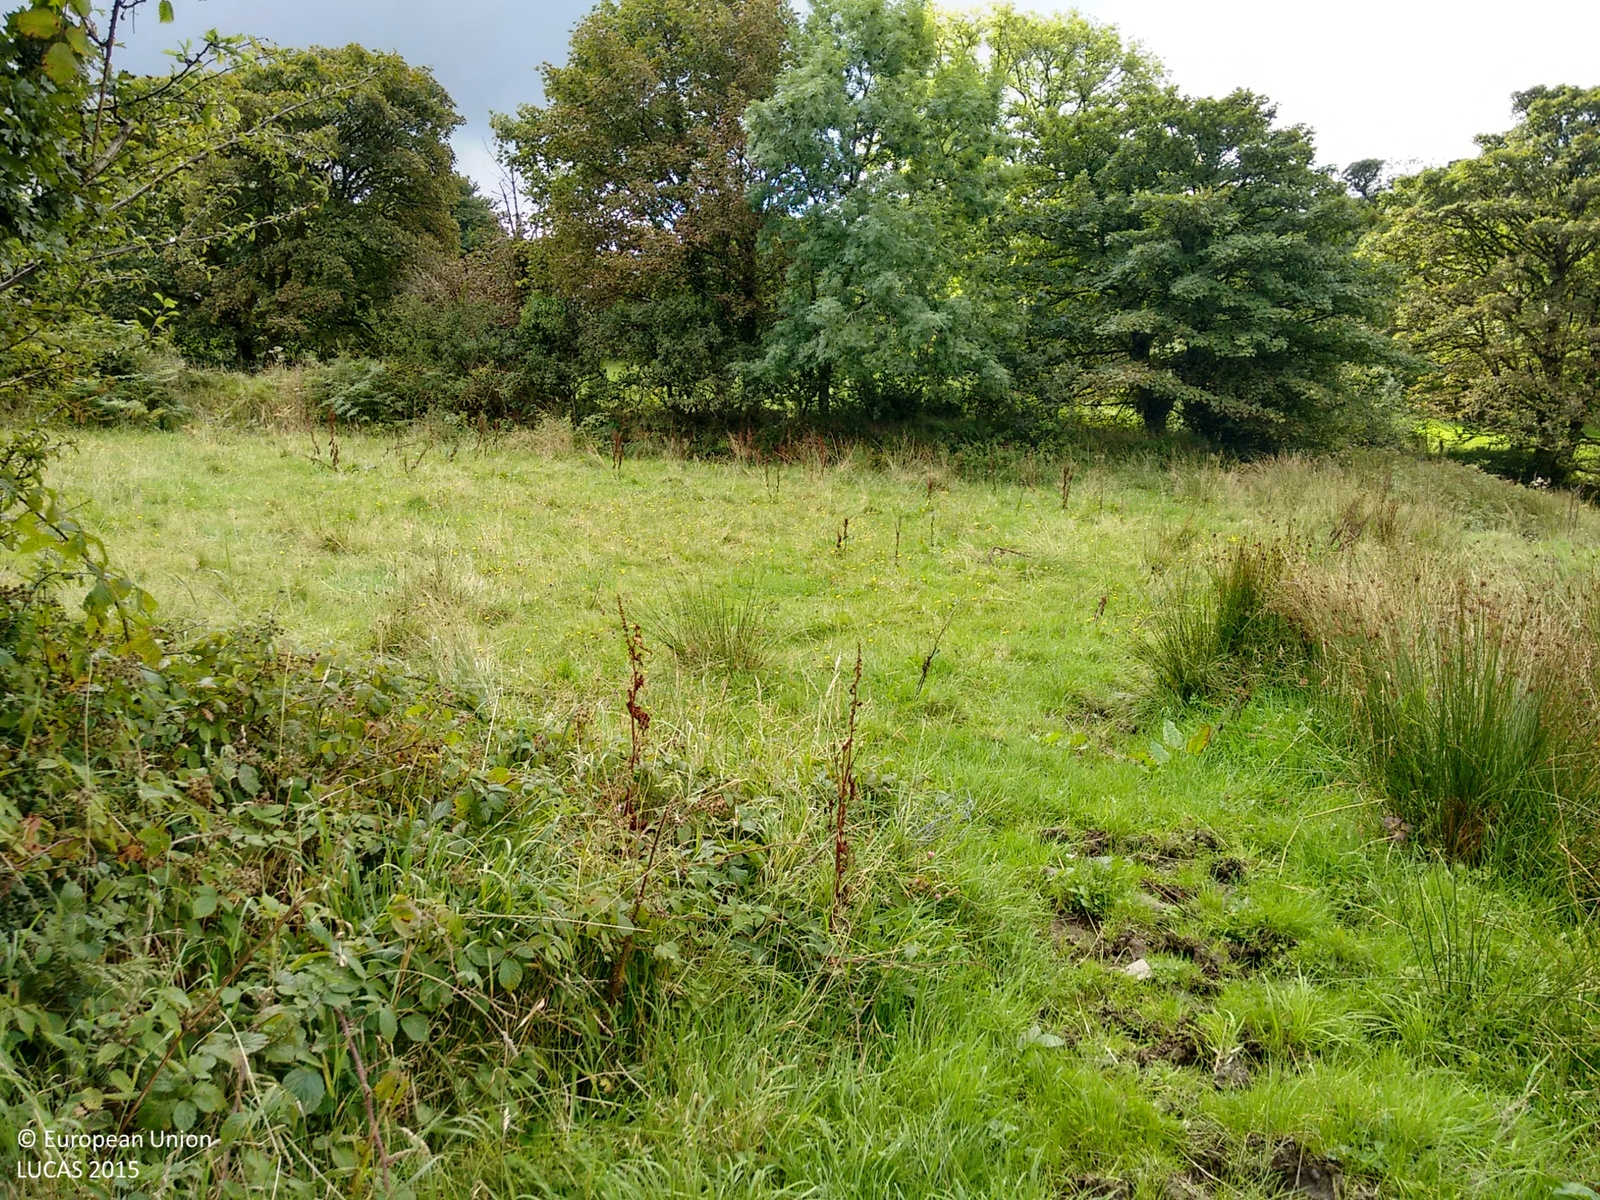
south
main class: Woodland
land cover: Broadleaved woodland
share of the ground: > 75 %
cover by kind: broadleaved forest trees 100 %
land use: Agriculture (excluding fallow land and kitchen gardens)
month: September
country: GB
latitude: 50.6026
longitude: -4.0689
